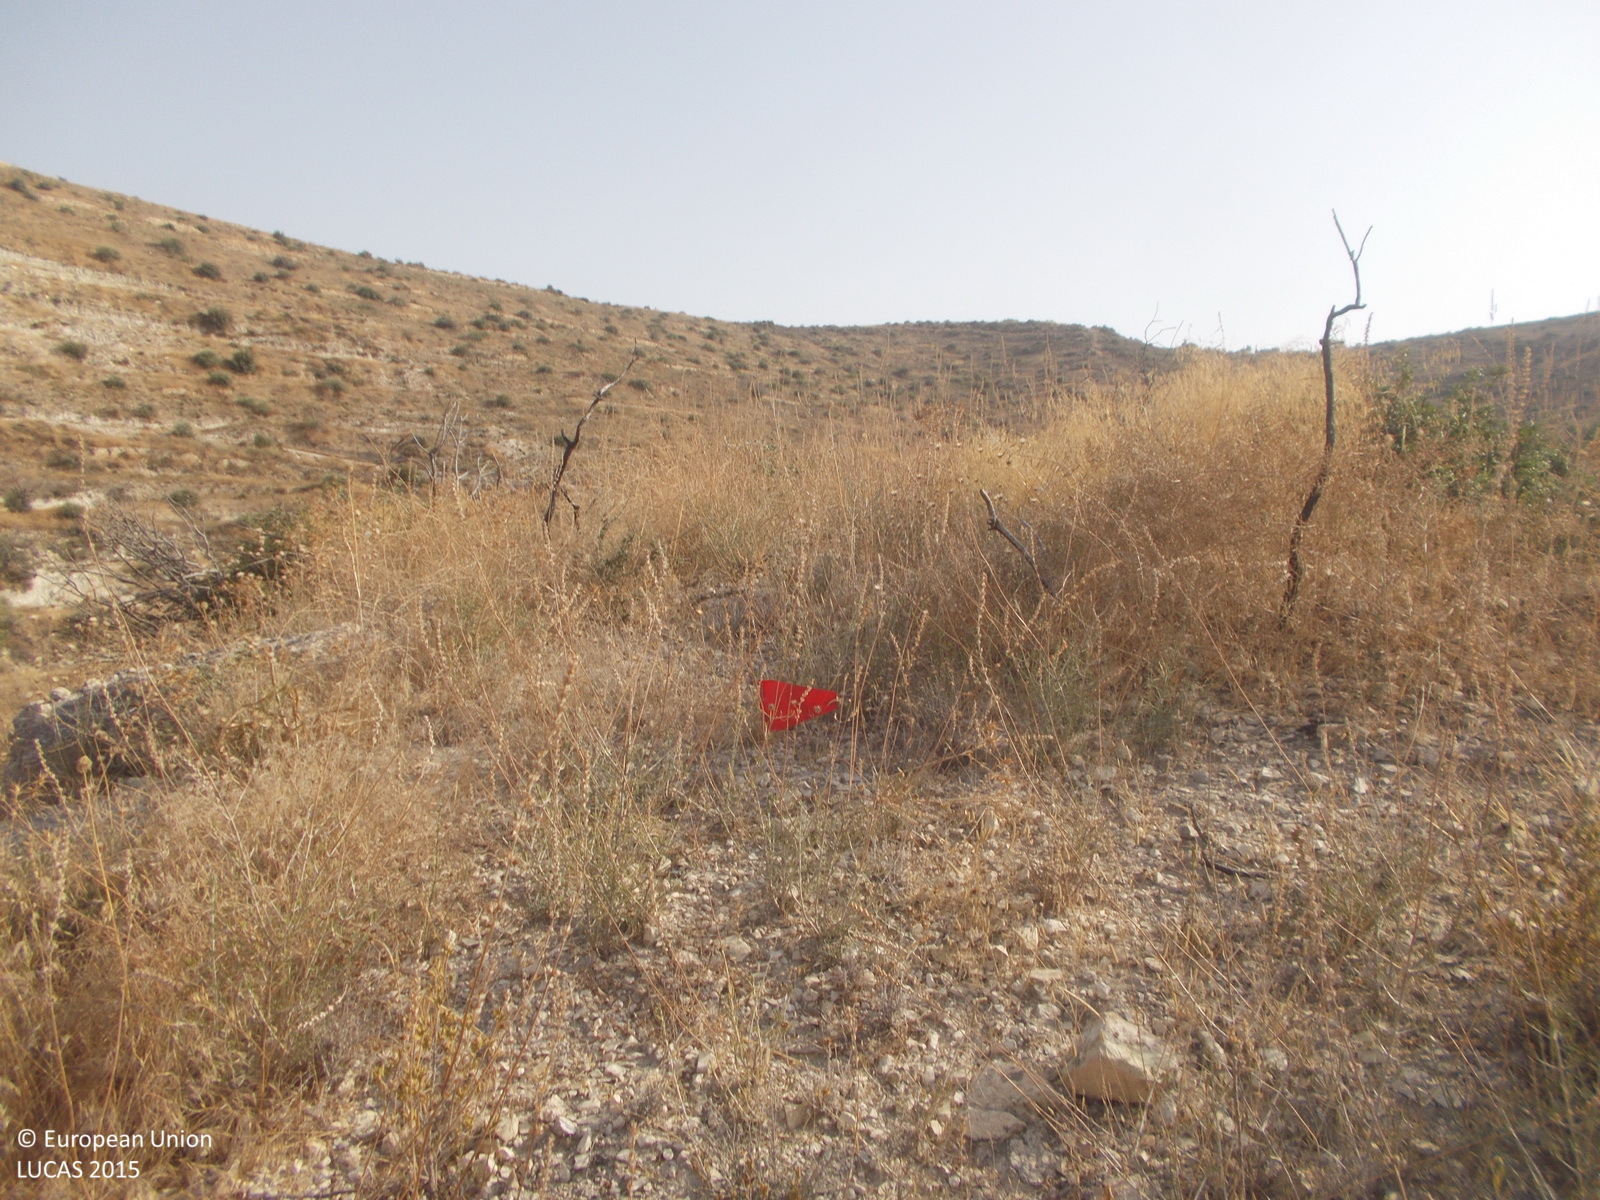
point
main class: Shrubland
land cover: Shrubland without tree cover
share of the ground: 50 - 75 %
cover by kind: shrubs 55 %, herbaceous plants 30 %, unconsolidated bare surface 15 %
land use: Semi-natural and natural areas not in use
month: April
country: CY
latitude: 34.8571
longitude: 33.3377
